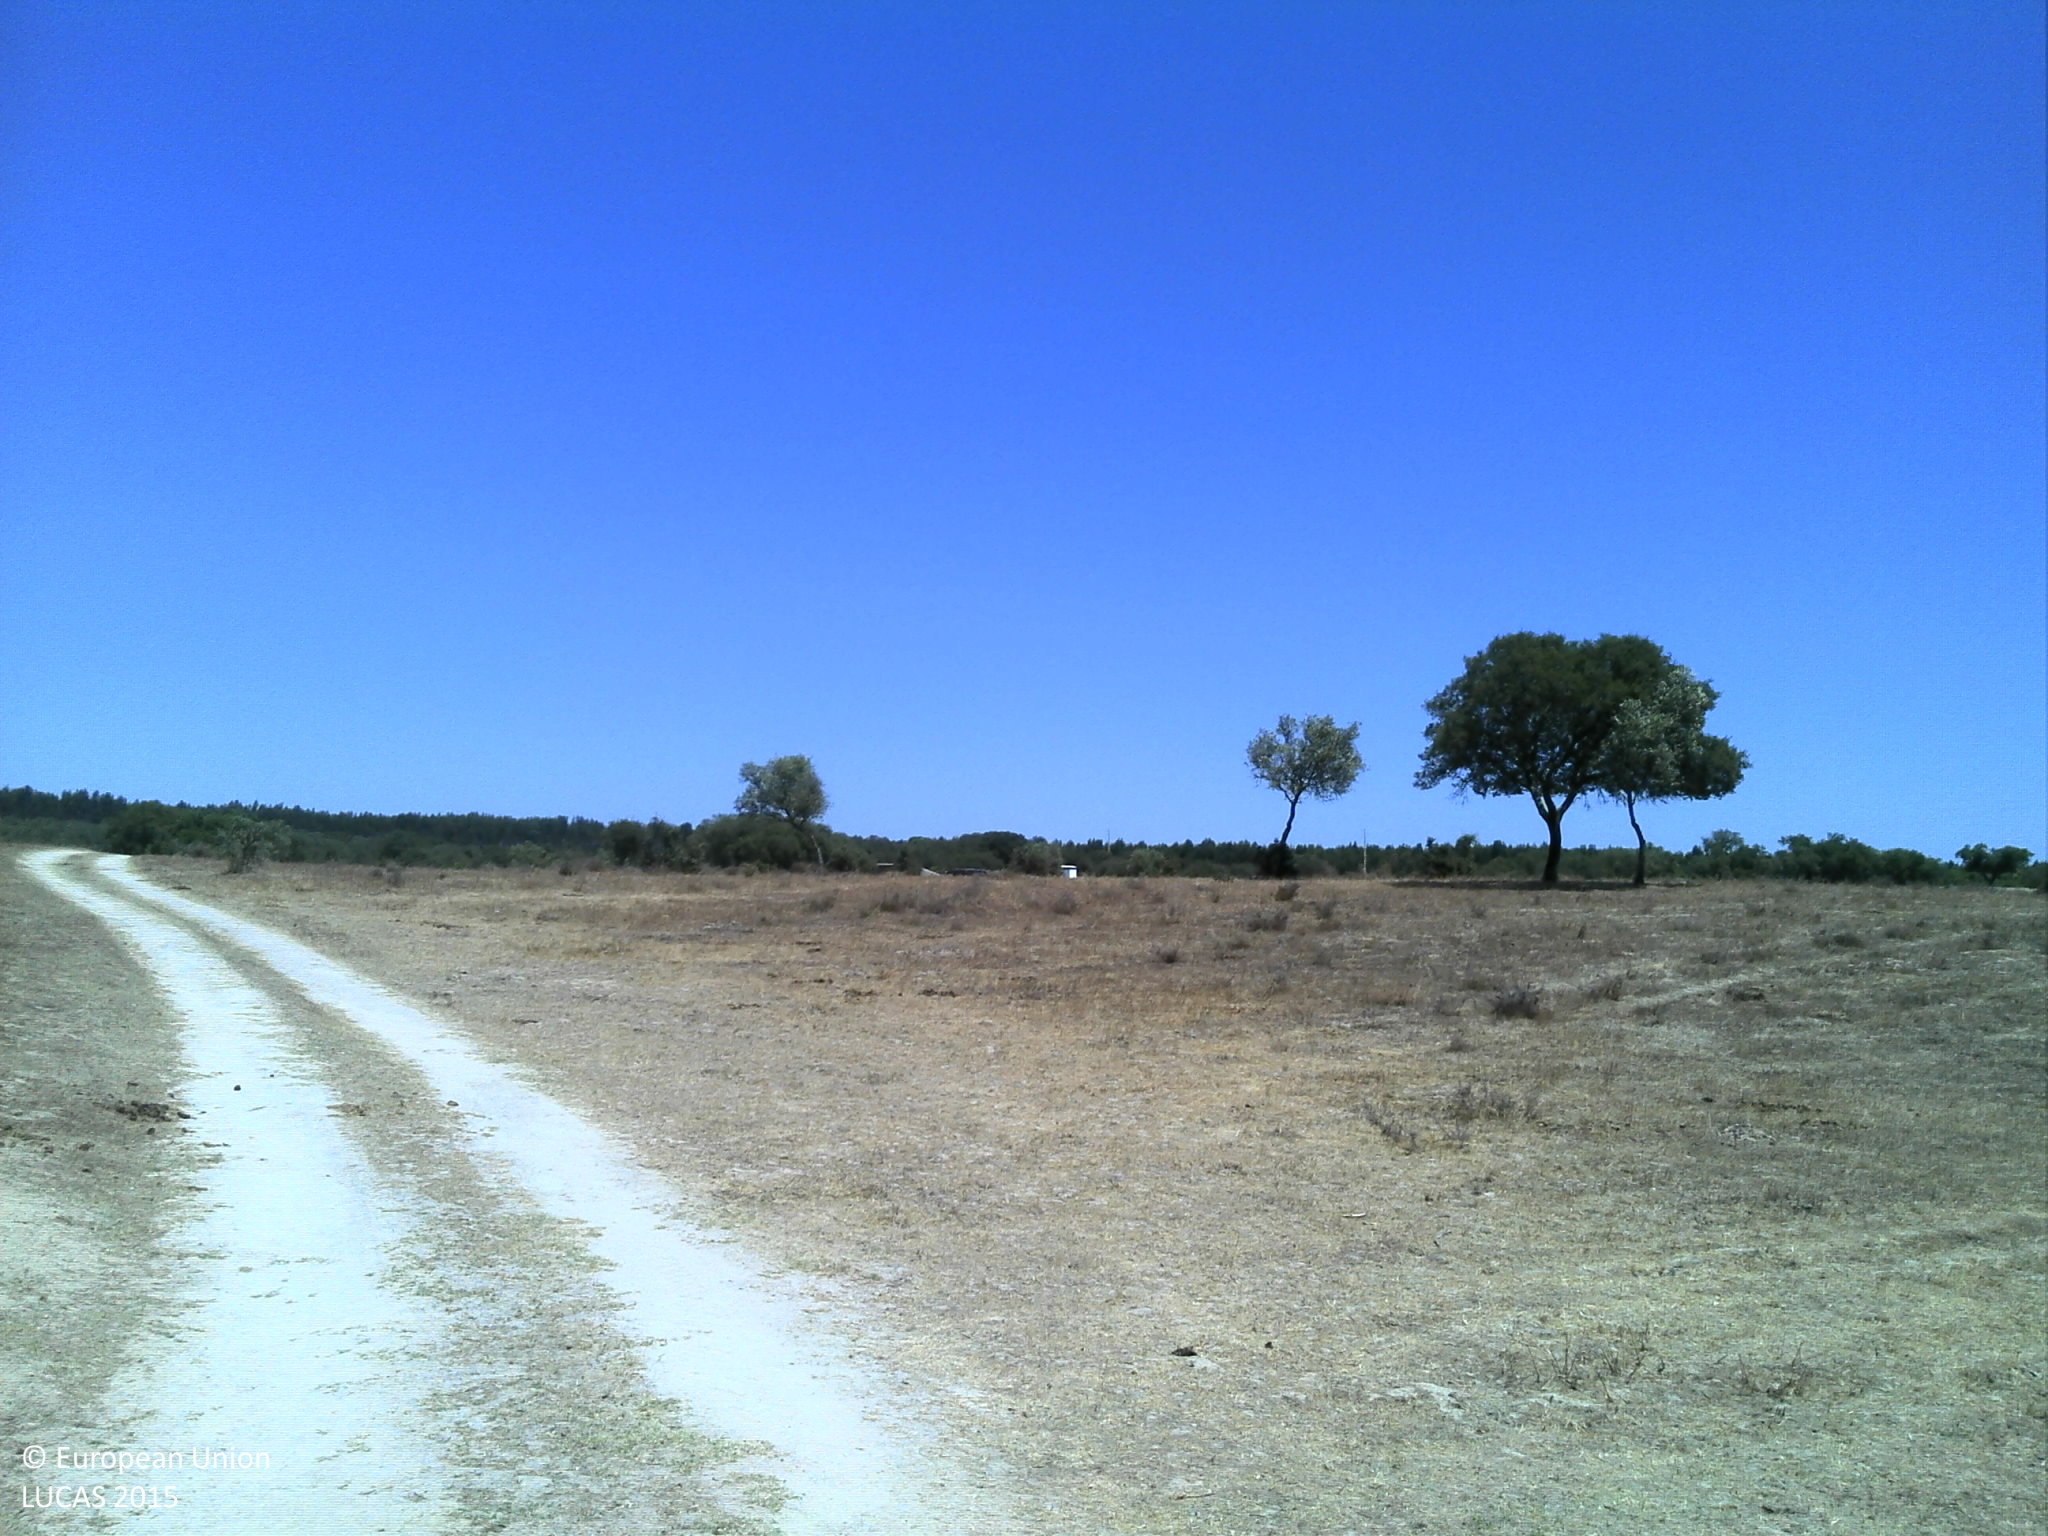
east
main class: Grassland
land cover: Grassland with sparse tree/shrub cover
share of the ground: 10 - 25 %
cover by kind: unconsolidated bare surface 80 %, herbaceous plants 15 %, broadleaved forest trees 5 %
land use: Agriculture (excluding fallow land and kitchen gardens)
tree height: > 5 m
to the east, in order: Grassland with sparse tree/shrub cover; Arable land (only in case pi); Shruby margins; Rivers and streams; Shruby margins; Arable land (only in case pi); Rocks and stones; Arable land (only in case pi); Rocks and stones
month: July
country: PT
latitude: 39.3241
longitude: -7.7153
